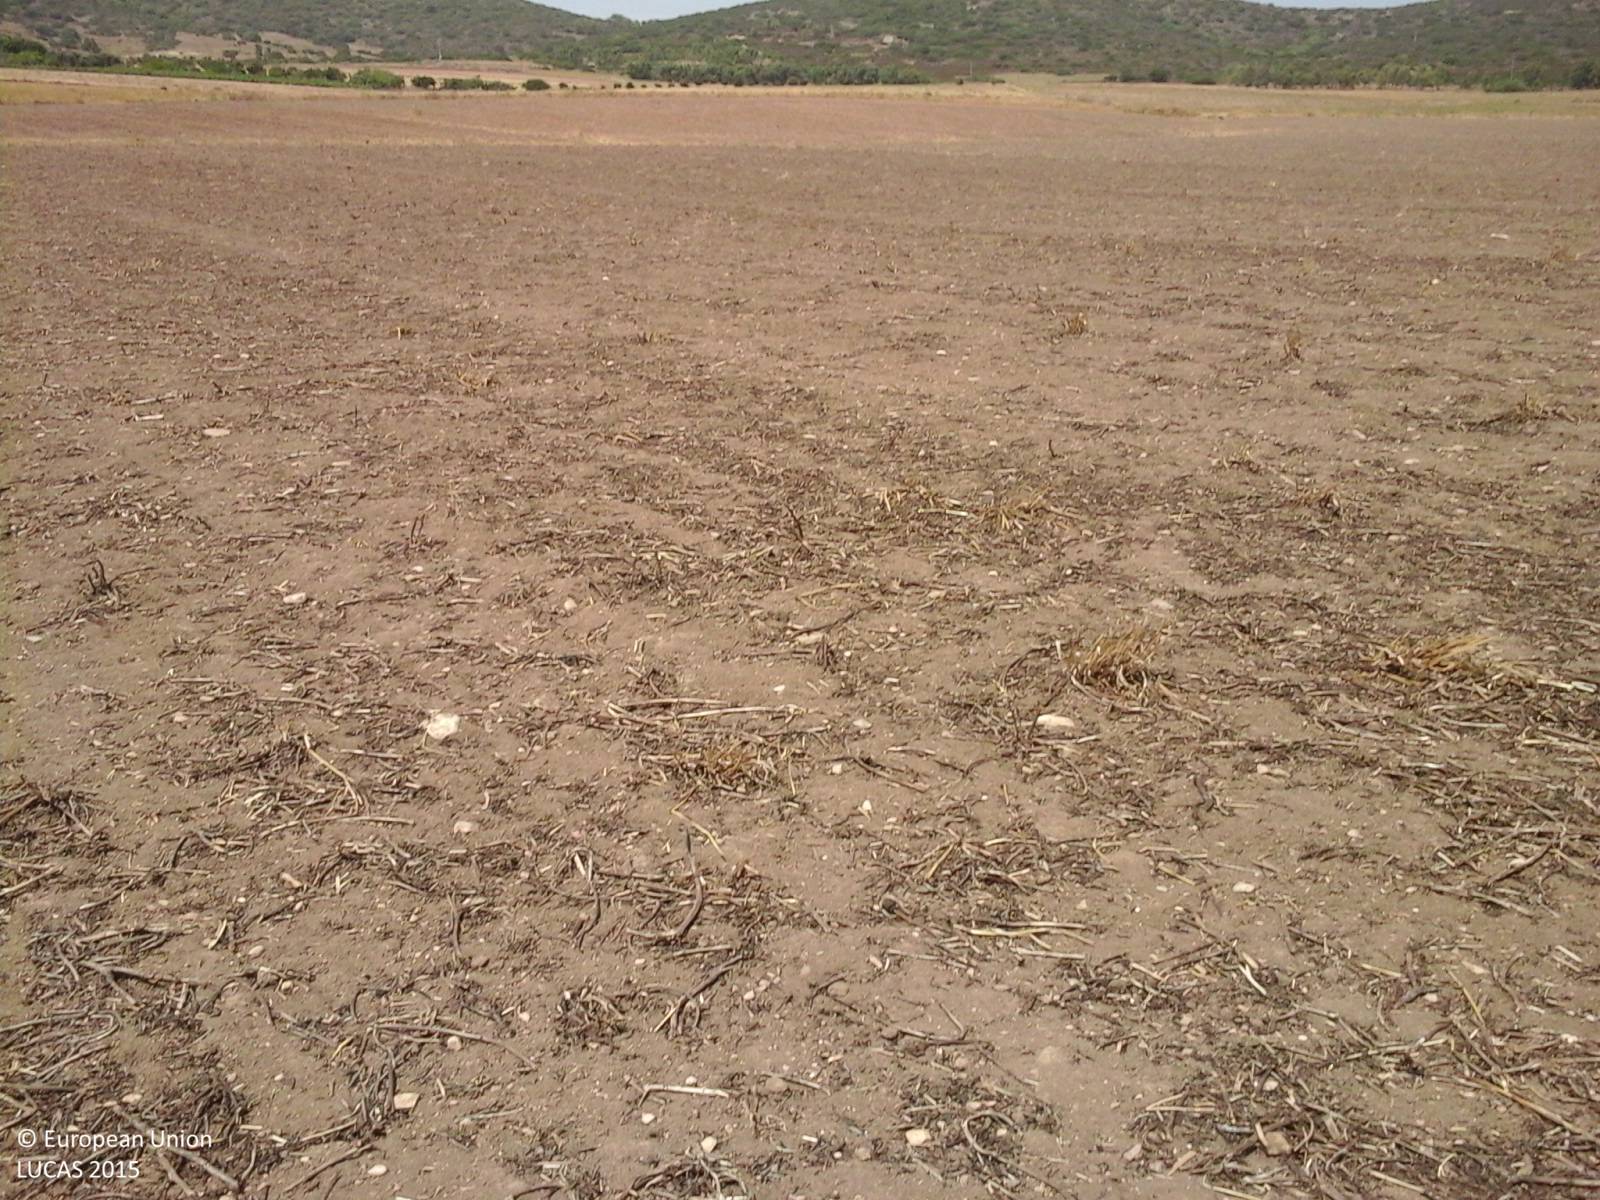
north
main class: Cropland
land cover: Oats
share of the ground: < 10 %
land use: Agriculture (excluding fallow land and kitchen gardens)
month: July
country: IT
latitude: 39.5900
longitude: 8.8076
